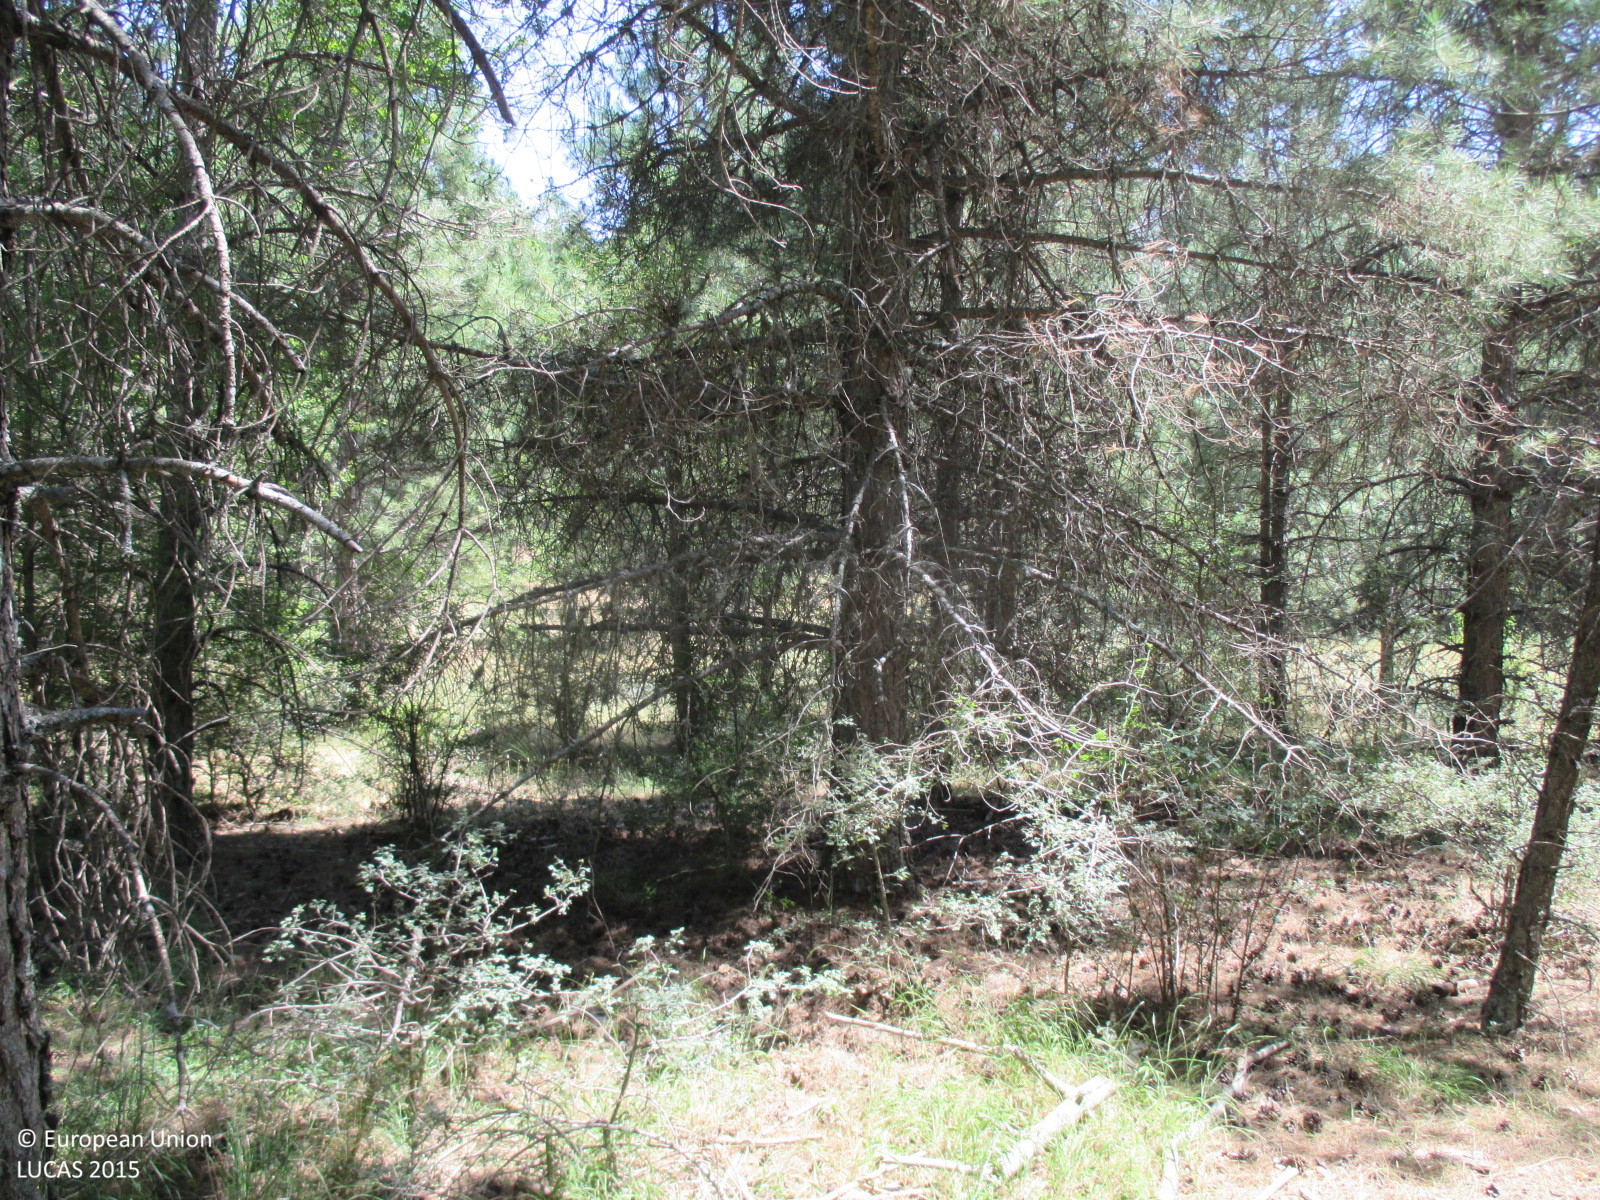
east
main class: Woodland
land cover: Pine dominated coniferous woodland
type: coniferous forest of the mediterranean region
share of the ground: > 75 %
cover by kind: coniferous forest trees 90 %, shrubs 5 %, herbaceous plants 5 %
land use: Forestry
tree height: > 5 m
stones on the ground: < 10 %
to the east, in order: Pine dominated coniferous woodland; Tracks; Pine dominated coniferous woodland
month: July
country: ES
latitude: 38.3032
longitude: -2.5643
